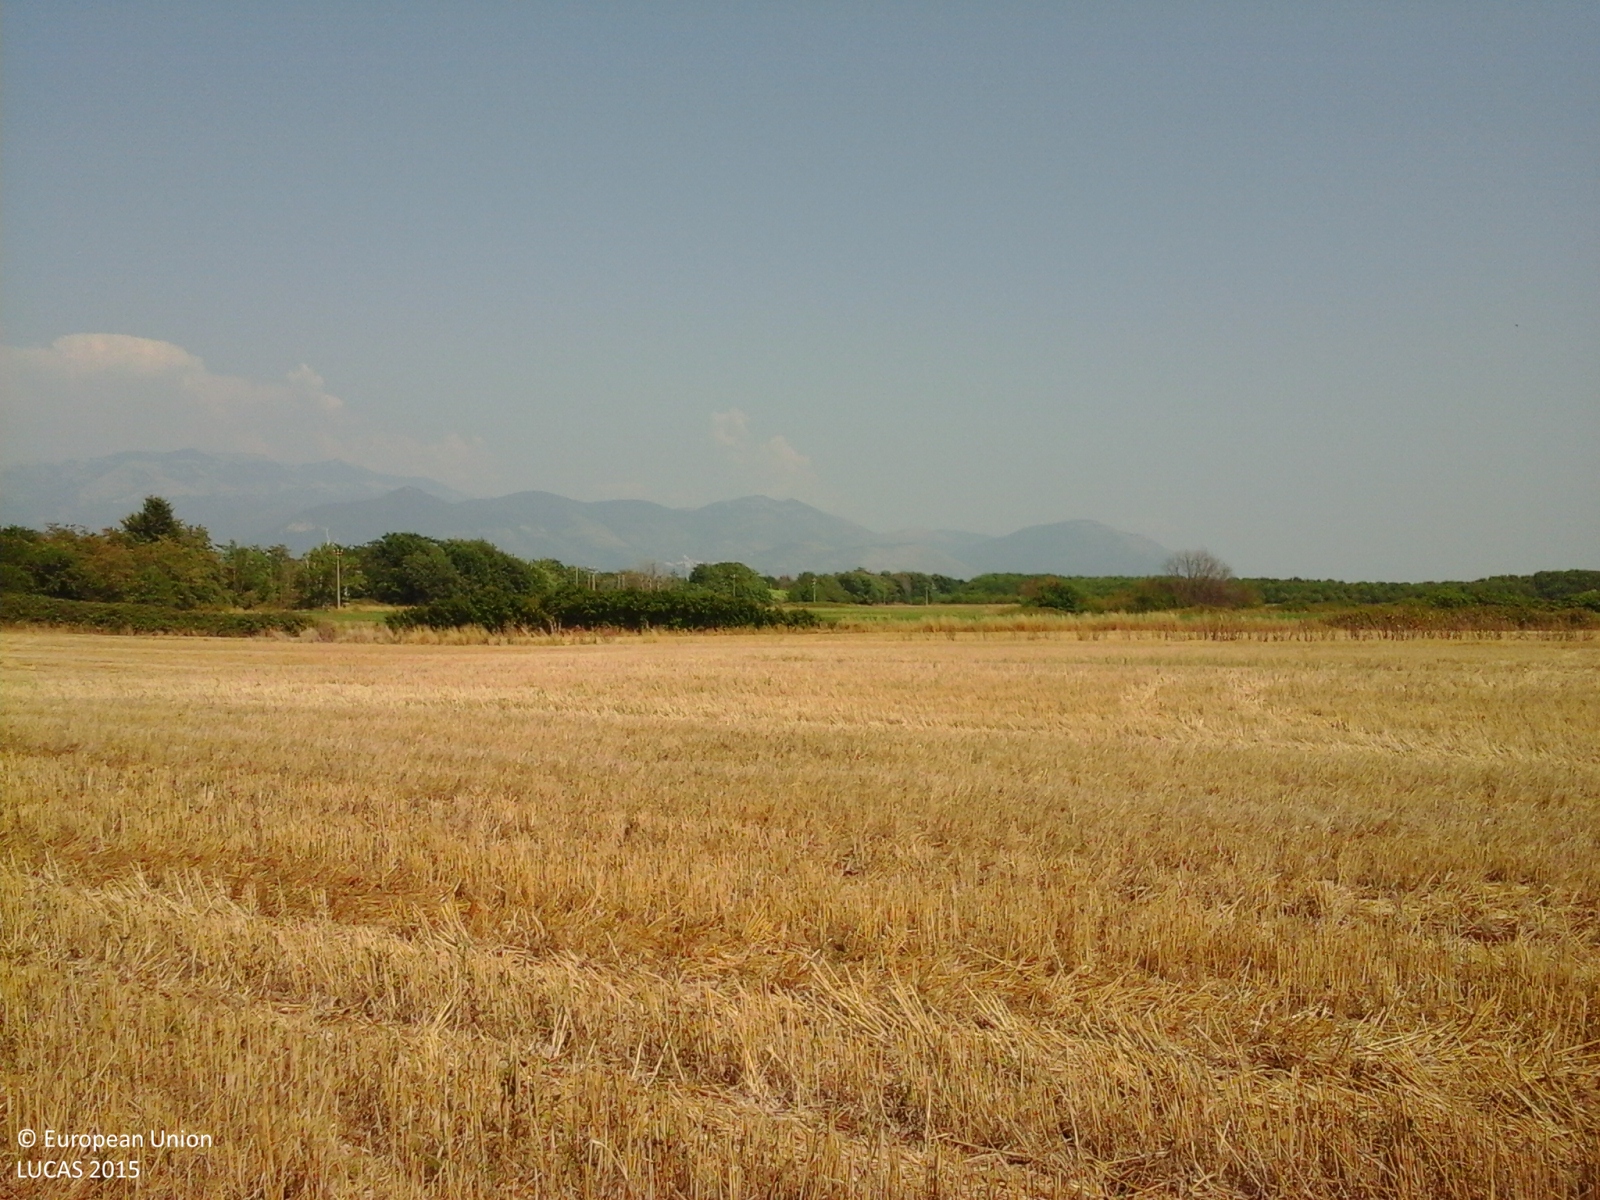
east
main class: Cropland
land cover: Durum wheat
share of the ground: > 75 %
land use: Agriculture (excluding fallow land and kitchen gardens)
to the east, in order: Durum wheat; Shruby margins; Lucerne; Electric lines; Grass margins; Fences; Ditches and canals
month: July
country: IT
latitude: 41.5645
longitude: 12.8786
